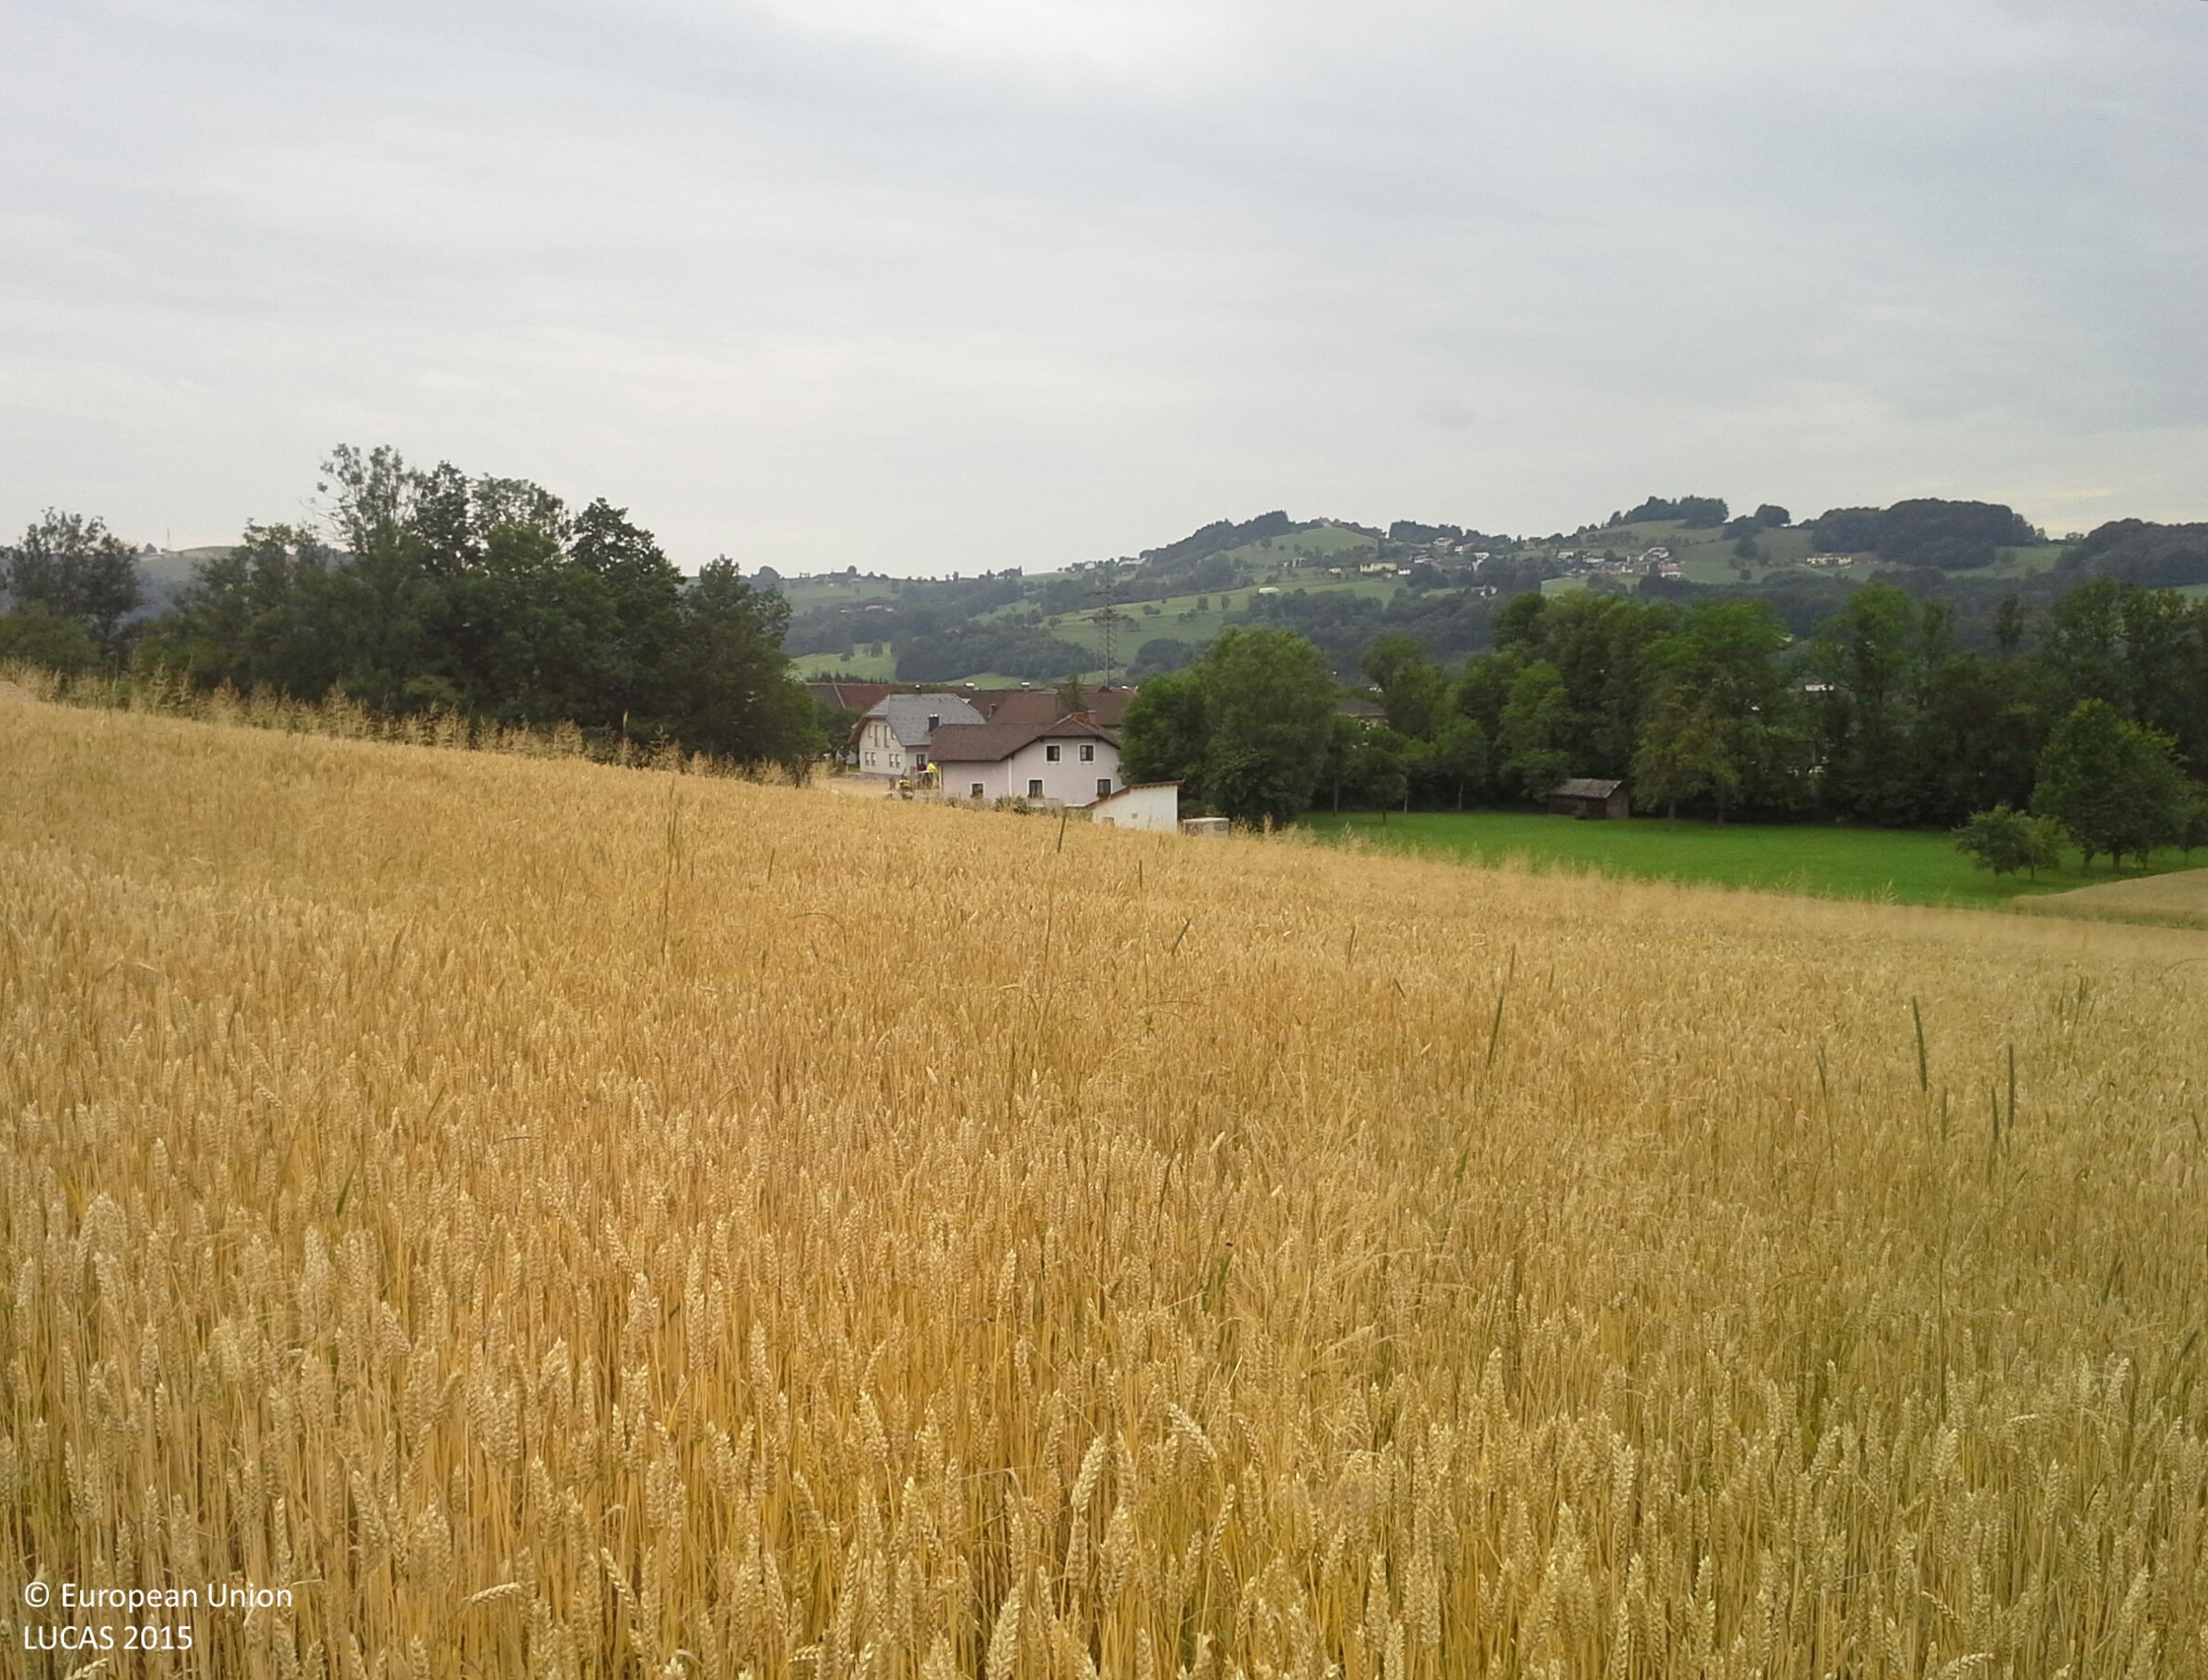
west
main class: Cropland
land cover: Common wheat
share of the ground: > 75 %
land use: Agriculture (excluding fallow land and kitchen gardens)
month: July
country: AT
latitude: 48.0126
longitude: 14.7595
